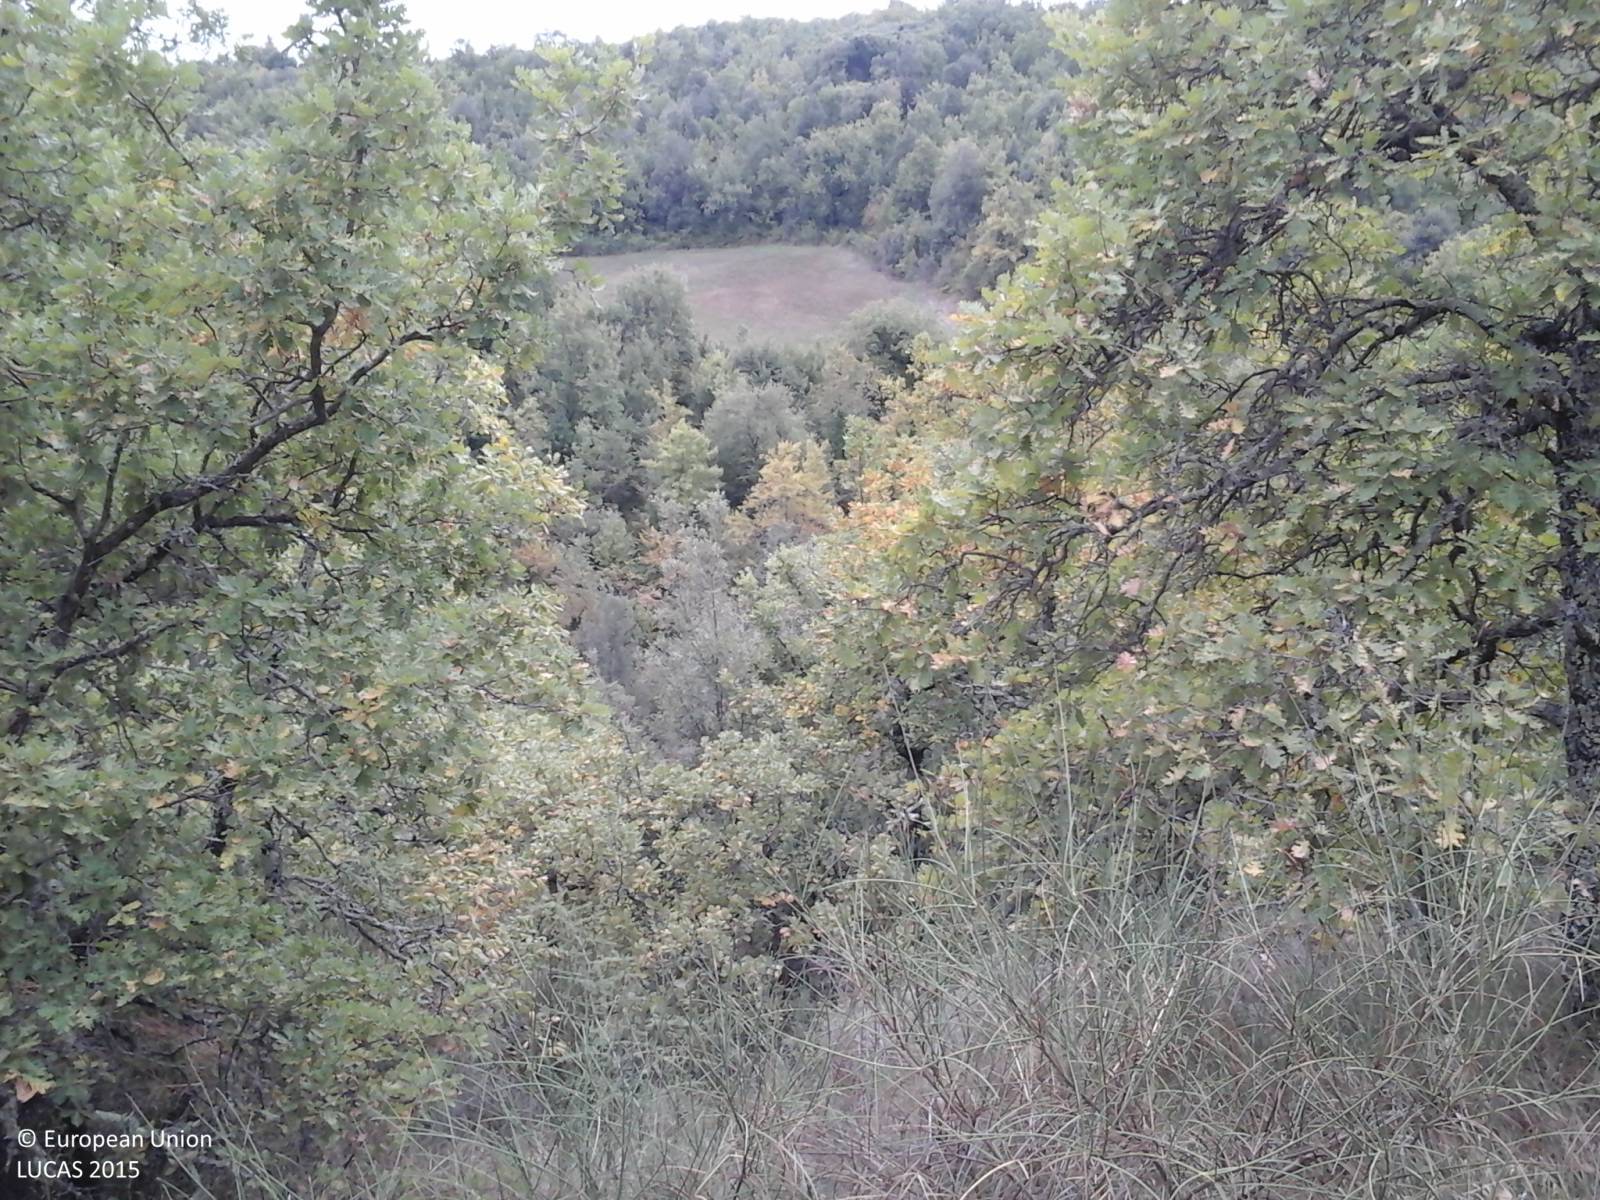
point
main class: Woodland
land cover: Broadleaved woodland
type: thermophilous deciduous forest
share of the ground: > 75 %
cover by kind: broadleaved forest trees 100 %
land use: Forestry
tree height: > 5 m
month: September
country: IT
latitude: 42.9365
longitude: 12.2357
